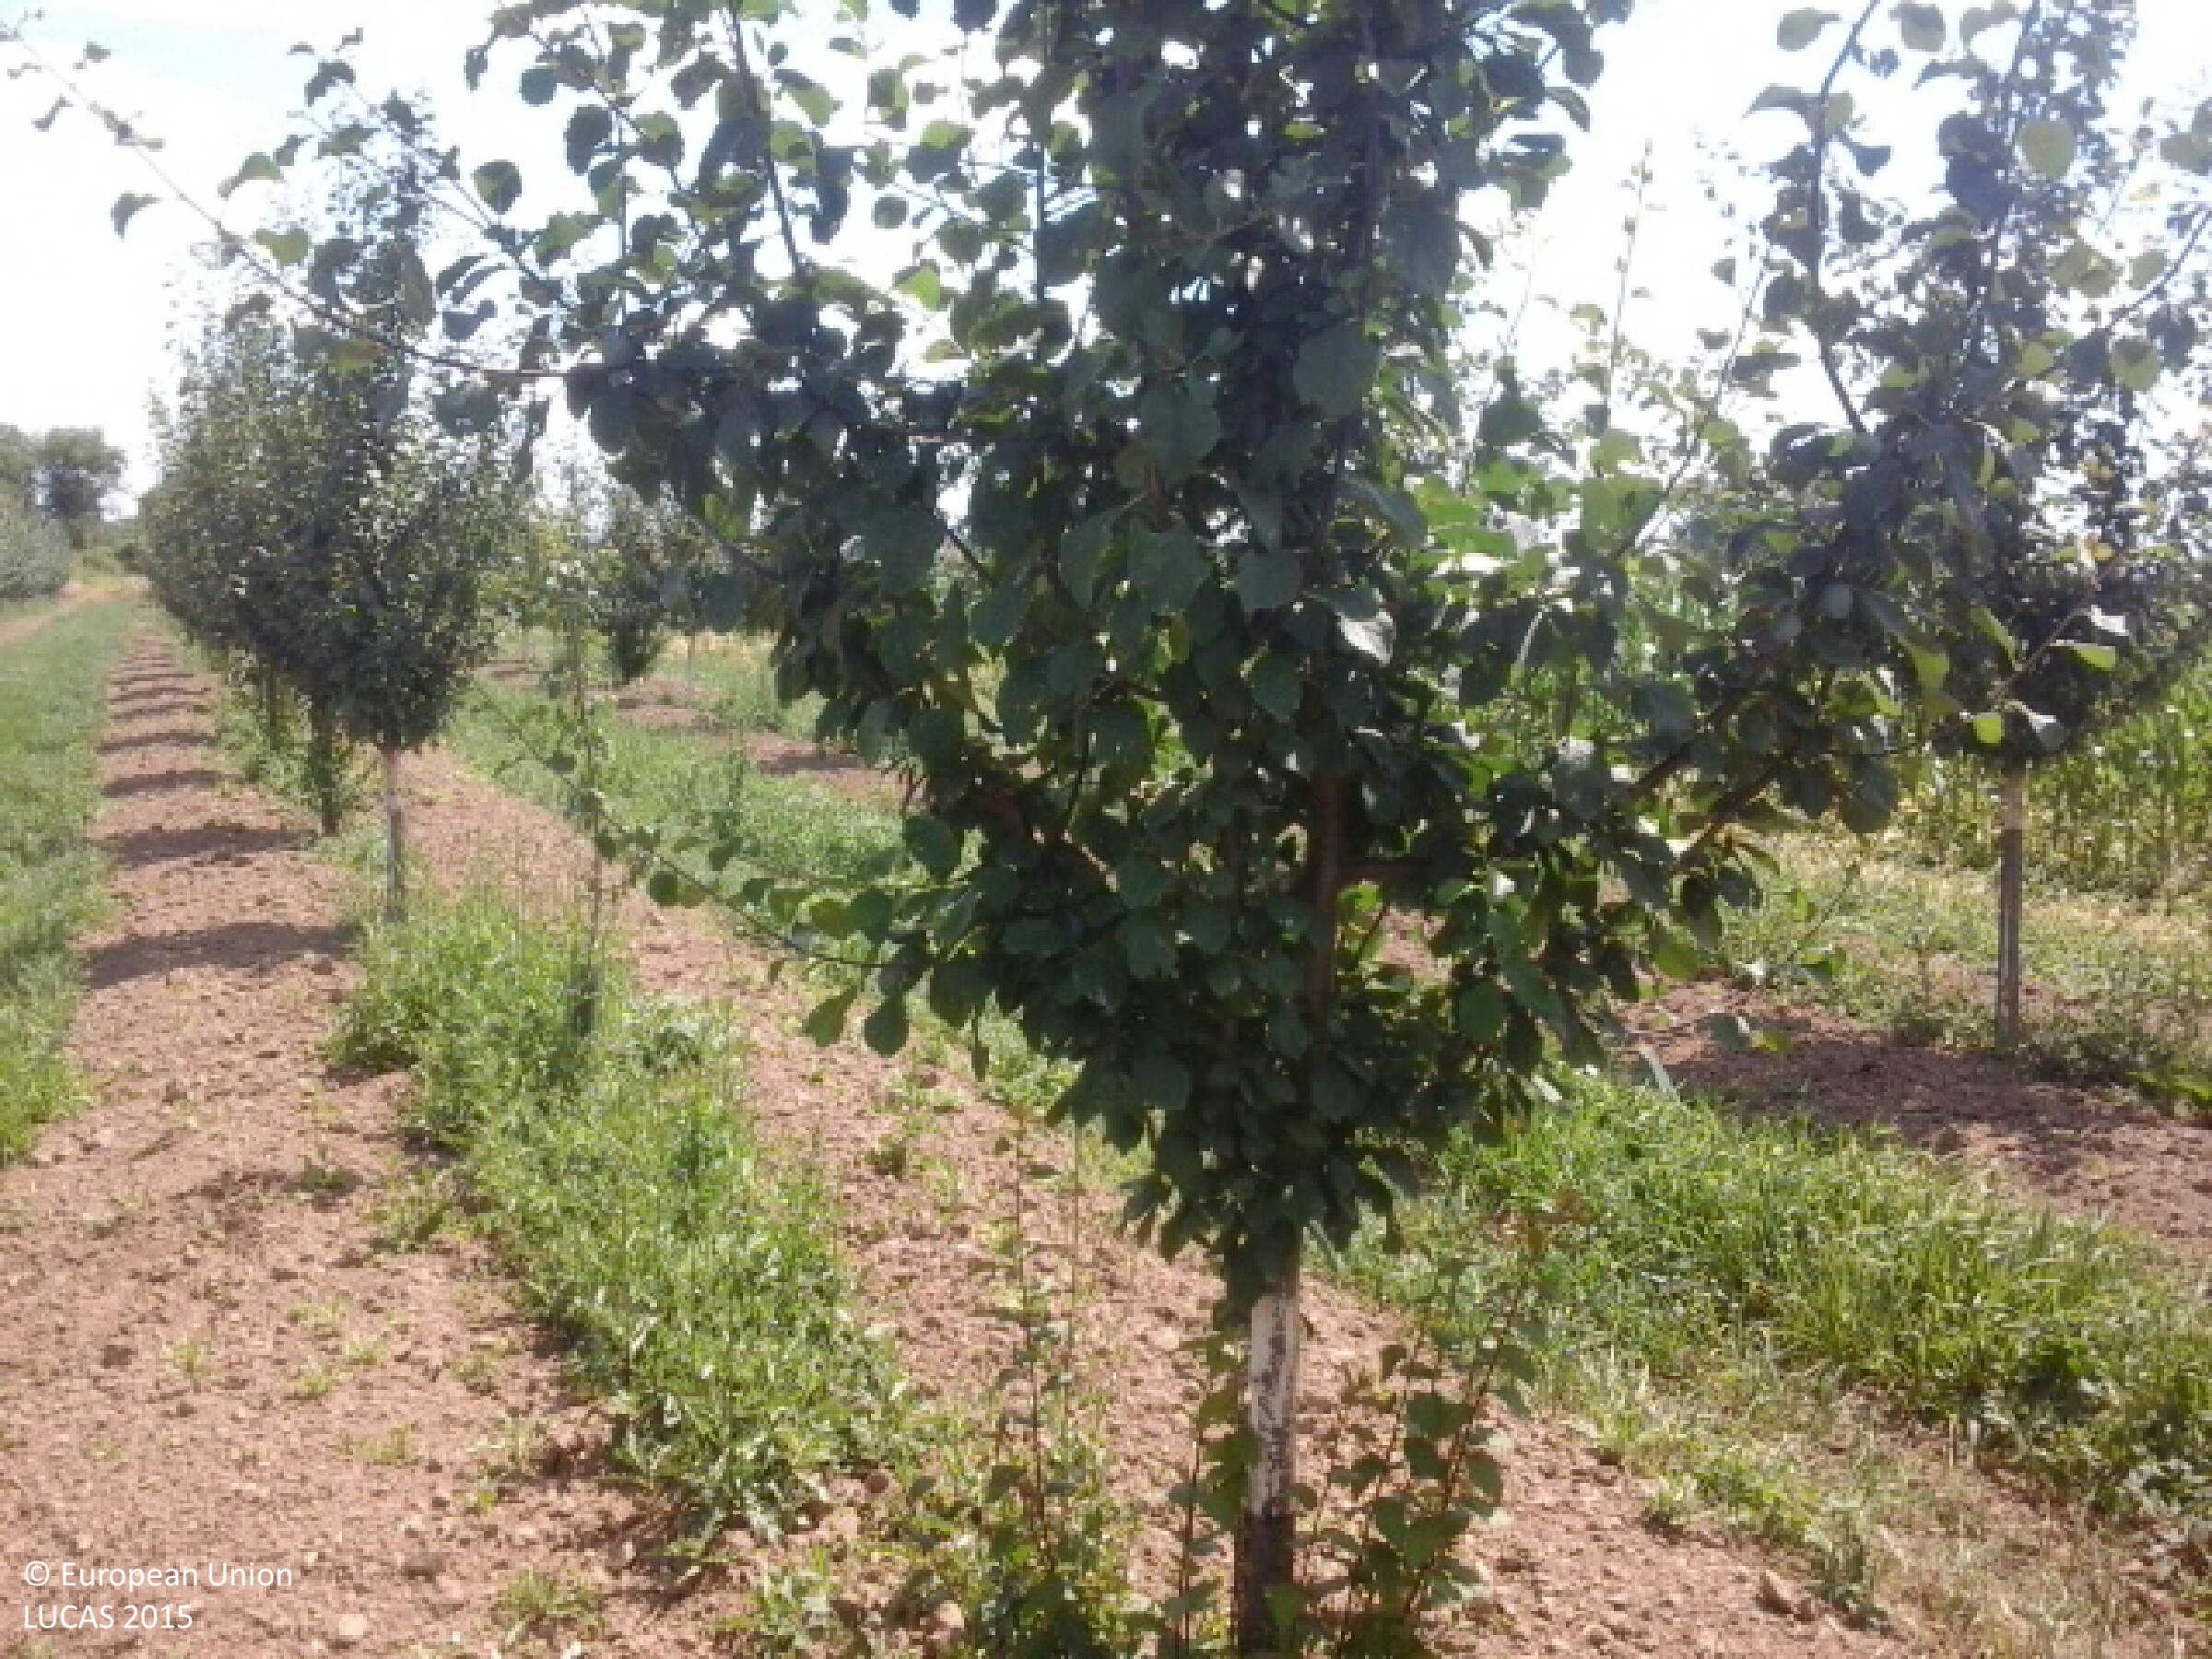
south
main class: Cropland
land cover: Other fruit trees and berries
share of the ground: 10 - 25 %
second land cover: Grassland without tree/shrub cover
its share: > 75 %
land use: Agriculture (excluding fallow land and kitchen gardens)
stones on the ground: < 10 %
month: July
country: HU
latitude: 48.2919
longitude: 22.0090
